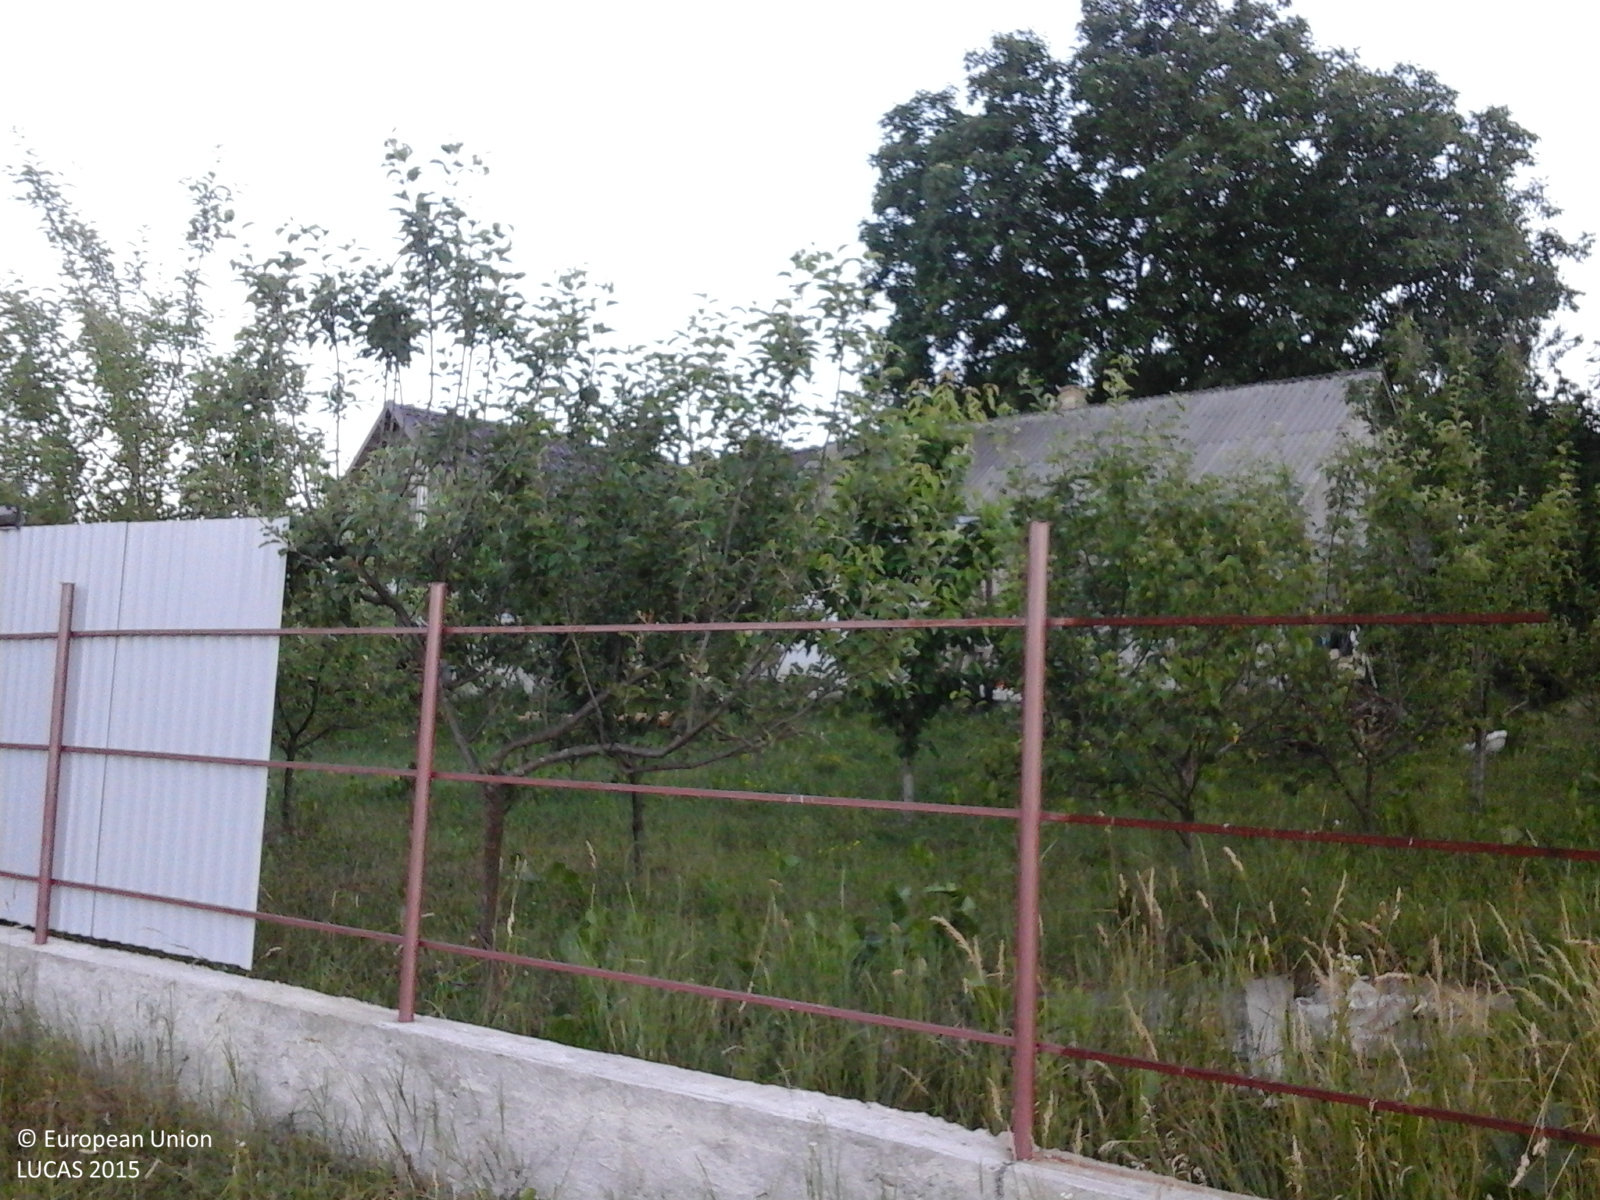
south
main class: Cropland
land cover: Apple fruit
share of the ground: > 75 %
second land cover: Grassland without tree/shrub cover
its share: > 75 %
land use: Kitchen garden
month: June
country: RO
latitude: 47.7358
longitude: 26.2864
